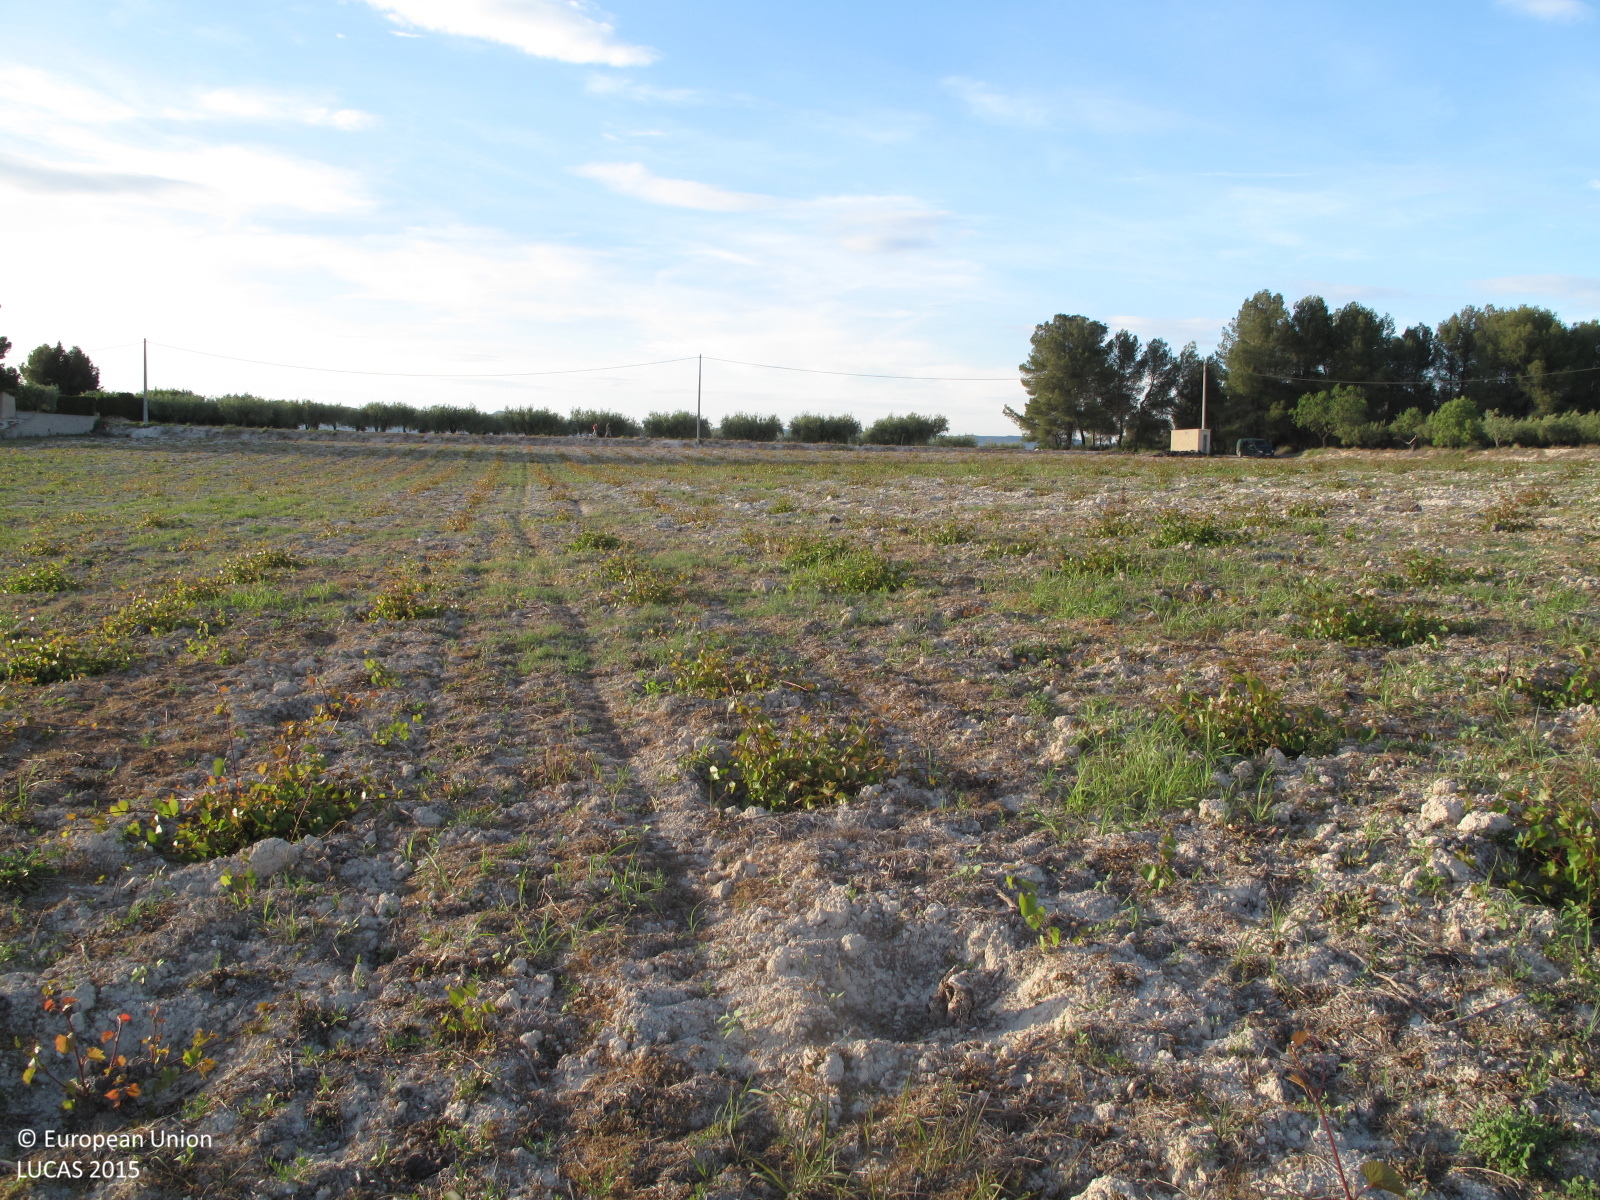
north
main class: Cropland
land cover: Vineyards
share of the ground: < 10 %
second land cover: Spontaneously vegetated surfaces
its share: 25 - 50 %
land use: Agriculture (excluding fallow land and kitchen gardens)
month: May
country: ES
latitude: 38.8388
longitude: -0.5556
